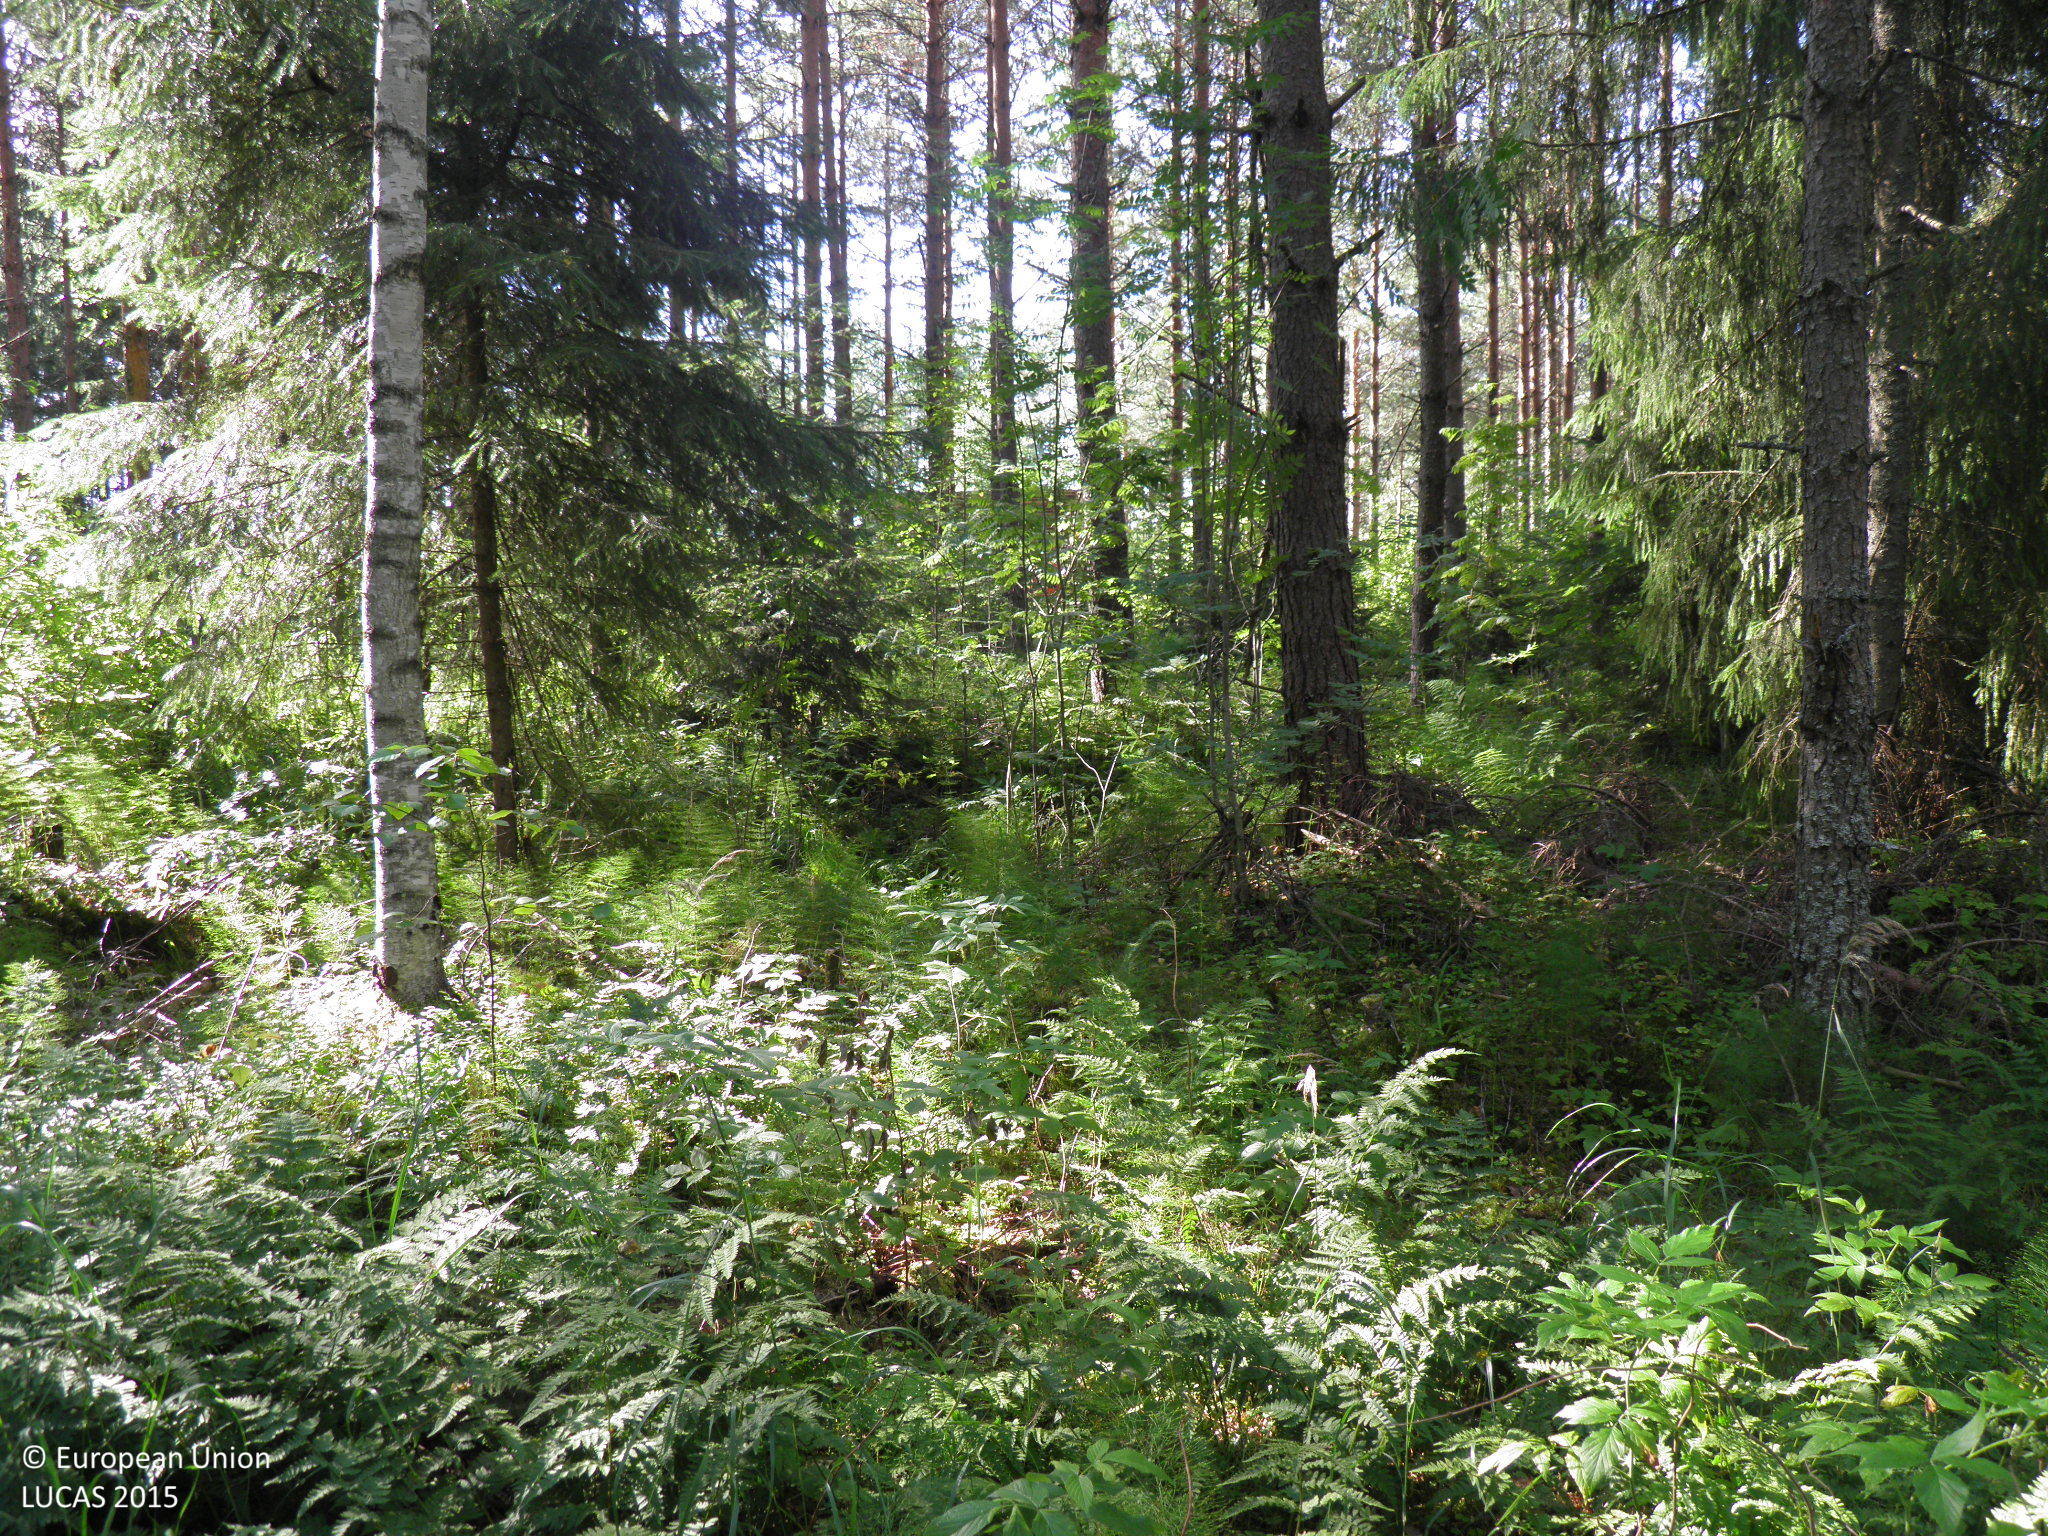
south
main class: Woodland
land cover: Pine dominated mixed woodland
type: hemiboreal forest and nemoral coniferous forest and mixed broadleaved-coniferous forest
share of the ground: > 75 %
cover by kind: broadleaved forest trees 50 %, coniferous forest trees 25 %, shrubs 25 %
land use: Forestry
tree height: > 5 m
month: August
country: FI
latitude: 61.0411
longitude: 22.5651
